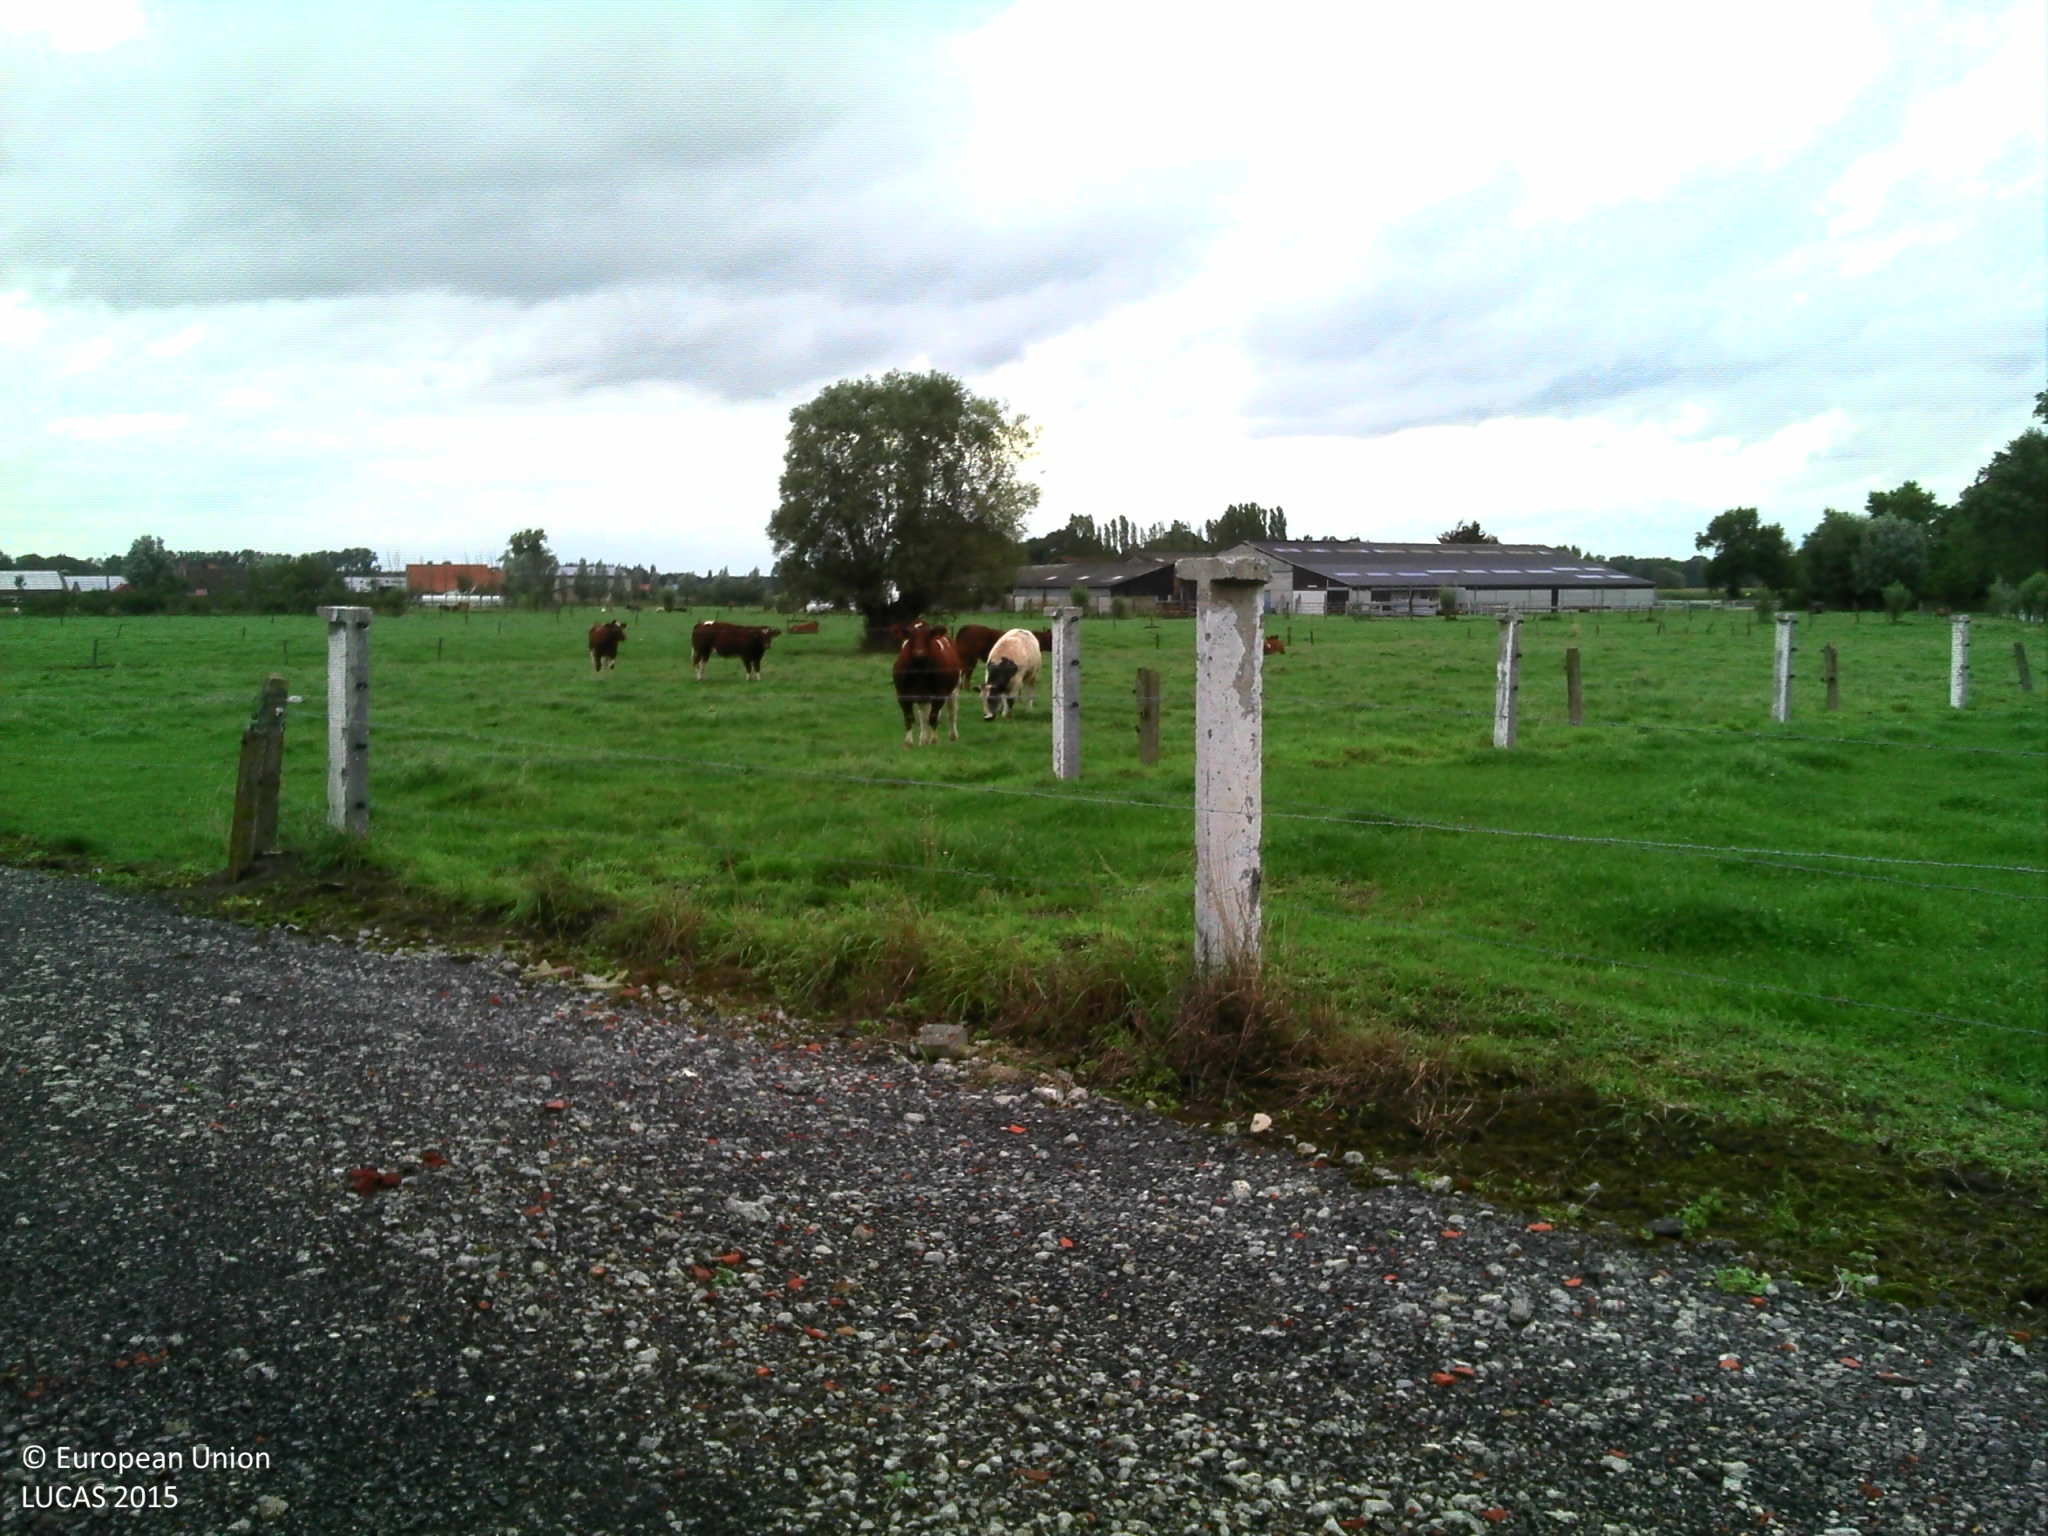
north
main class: Cropland
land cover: Maize
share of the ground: > 75 %
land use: Agriculture (excluding fallow land and kitchen gardens)
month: September
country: BE
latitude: 51.1294
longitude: 3.0884
